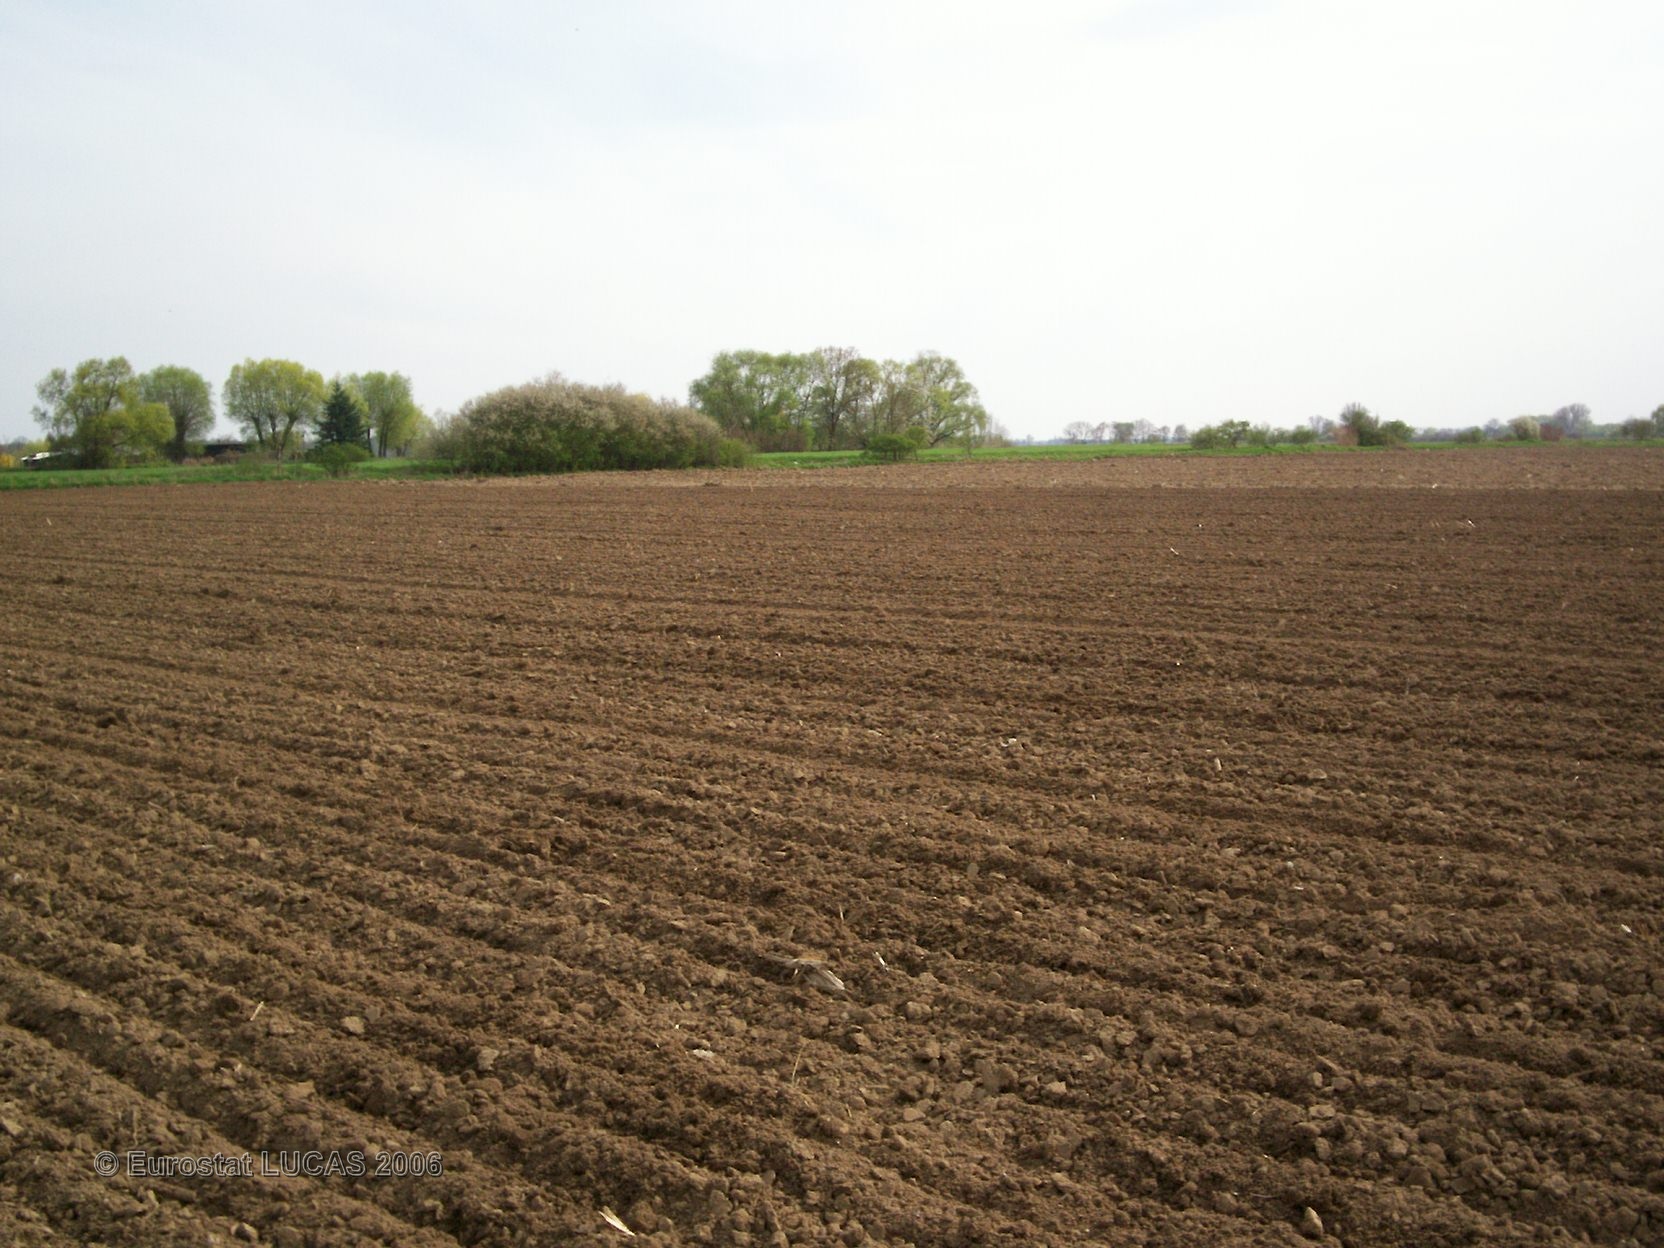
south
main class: Cropland
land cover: Maize
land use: Agriculture (excluding fallow land and kitchen gardens)
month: May
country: FR
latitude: 48.1391
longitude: 7.4074
